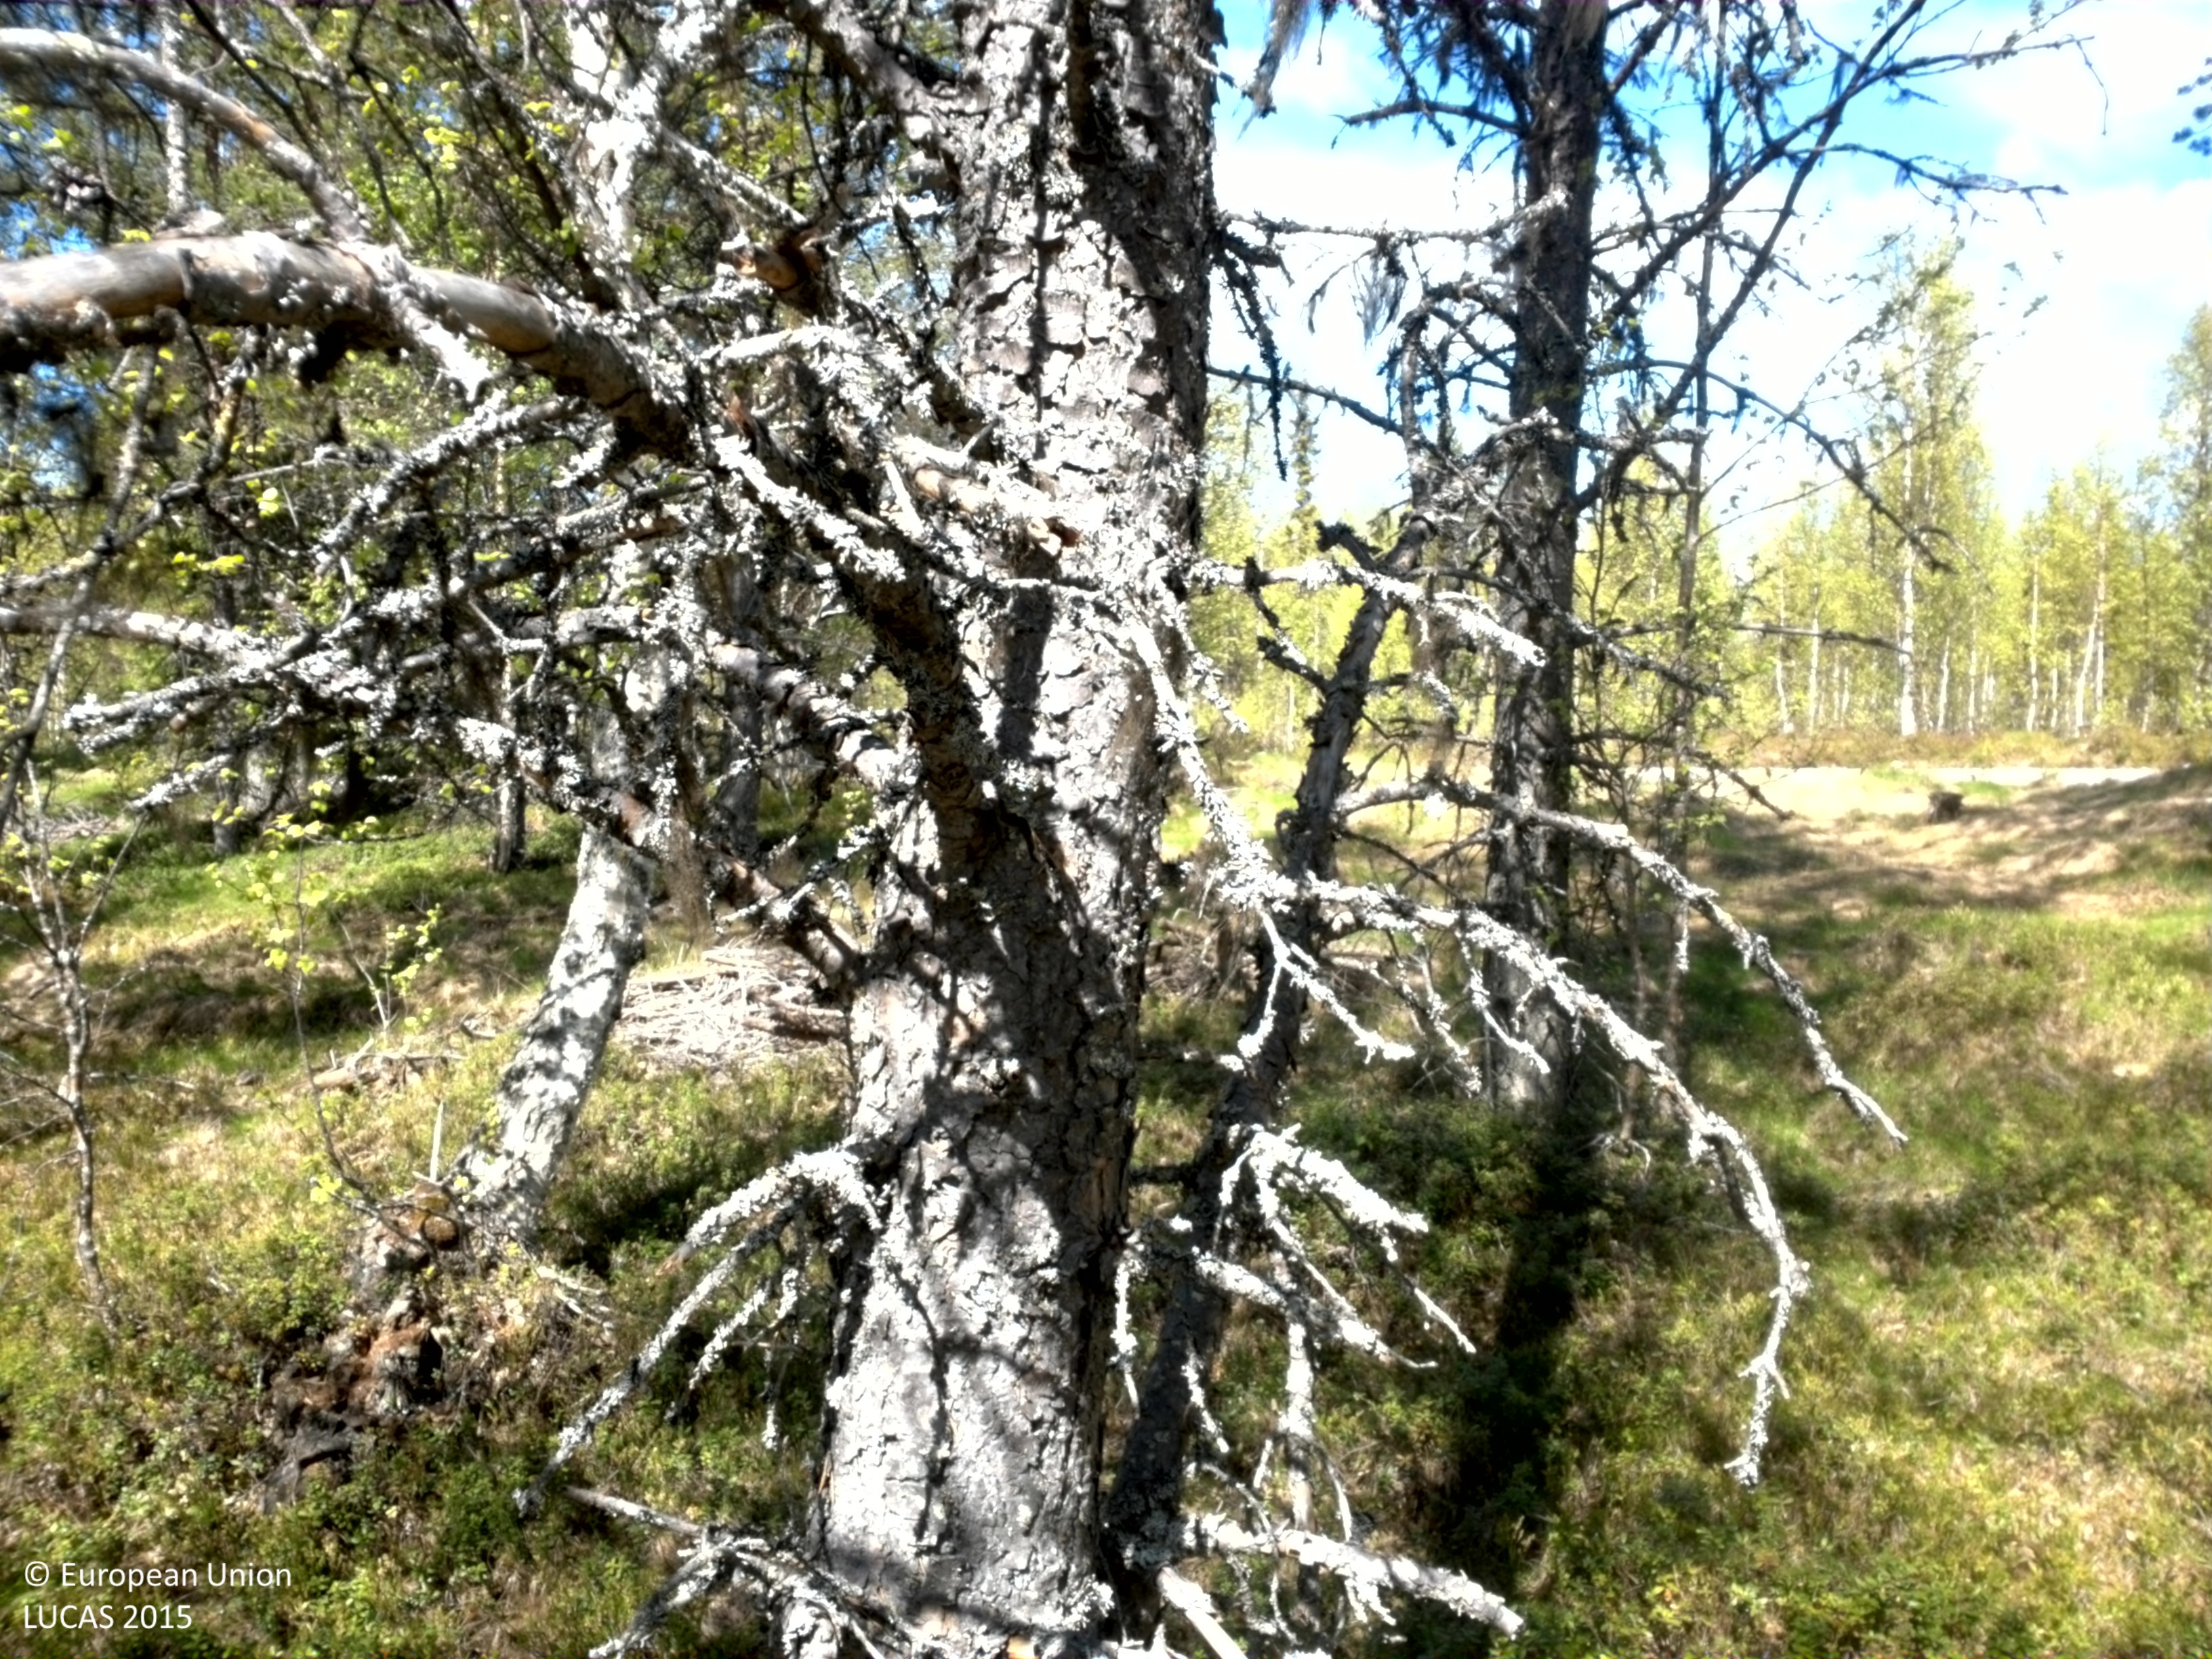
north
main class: Woodland
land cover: Pine dominated mixed woodland
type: boreal forest
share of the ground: 25 - 50 %
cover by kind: coniferous forest trees 30 %, herbaceous plants 30 %, broadleaved forest trees 20 %, shrubs 10 %, lichens and mosses 10 %
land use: Forestry
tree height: > 5 m
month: June
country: SE
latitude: 64.3543
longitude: 17.3611
